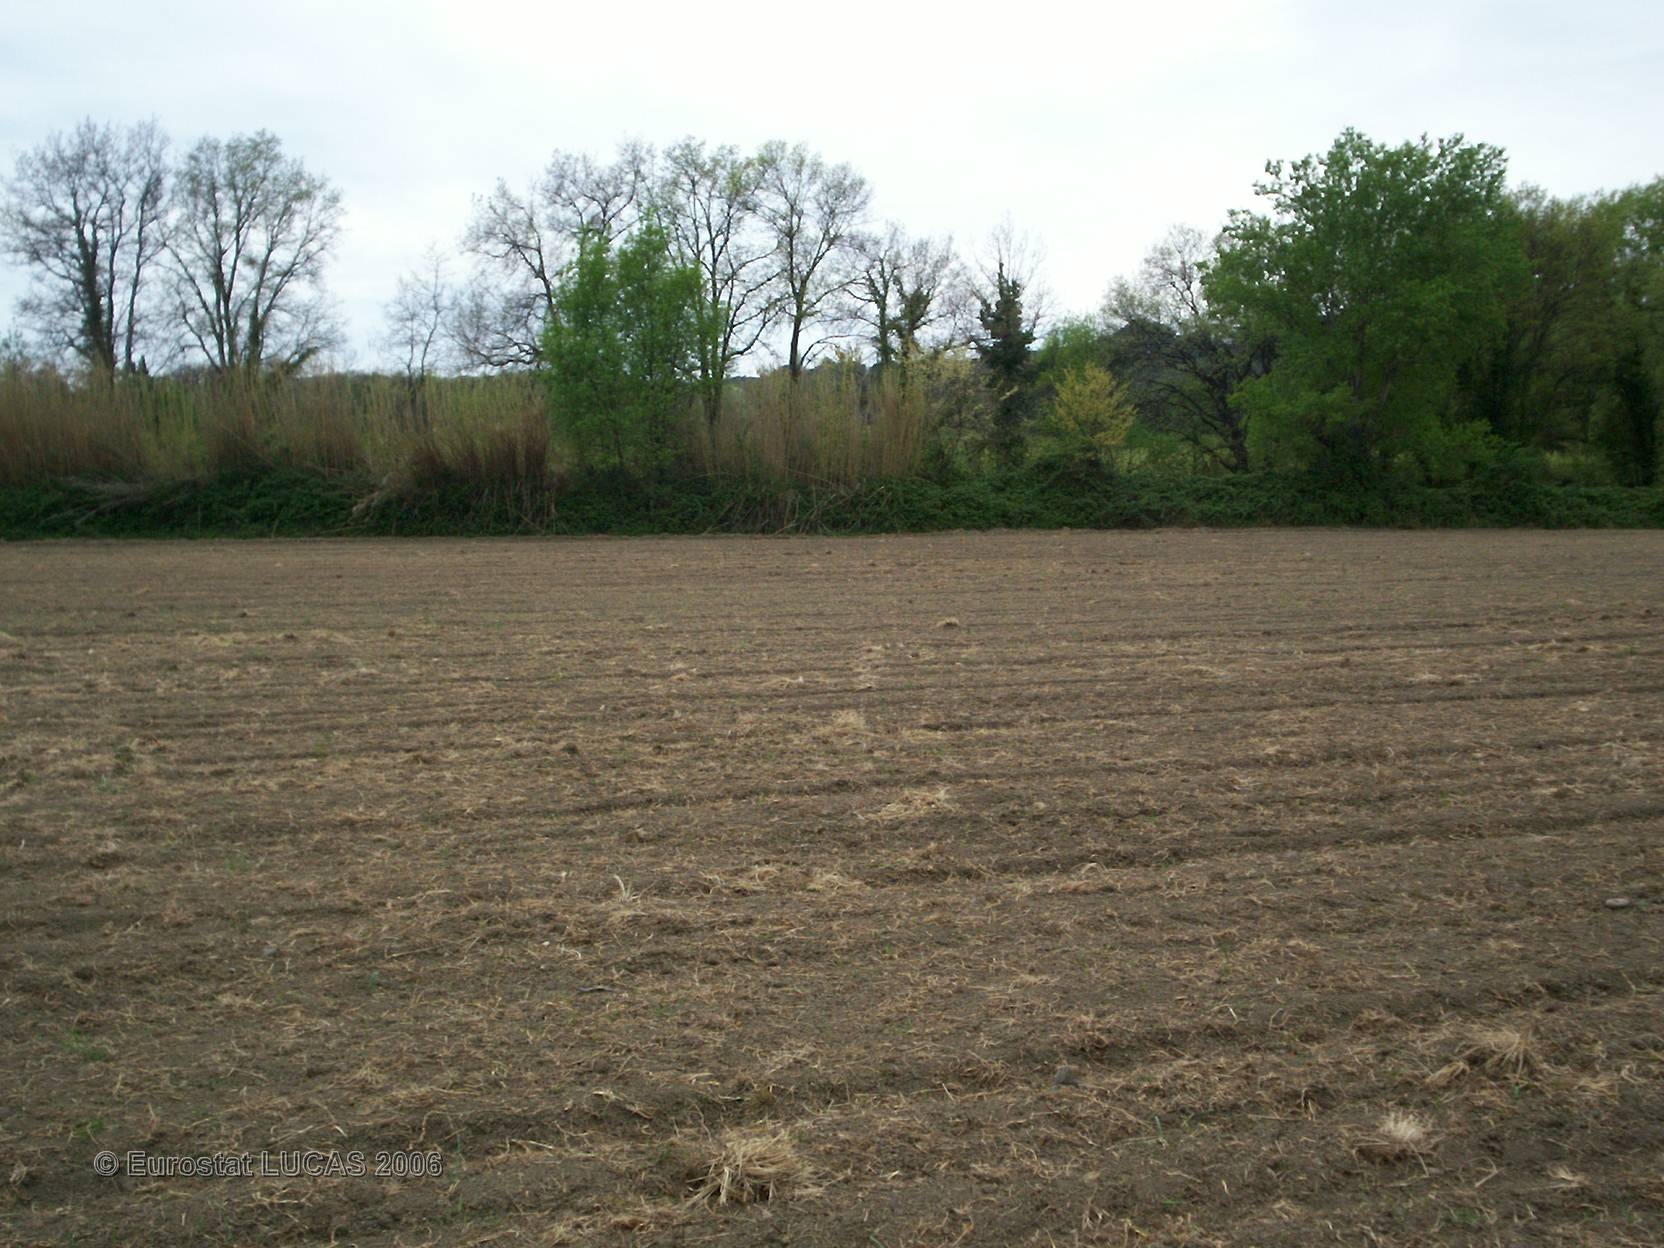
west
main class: Cropland
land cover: Lucerne
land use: Agriculture (excluding fallow land and kitchen gardens)
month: June
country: FR
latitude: 43.8455
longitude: 4.8966
